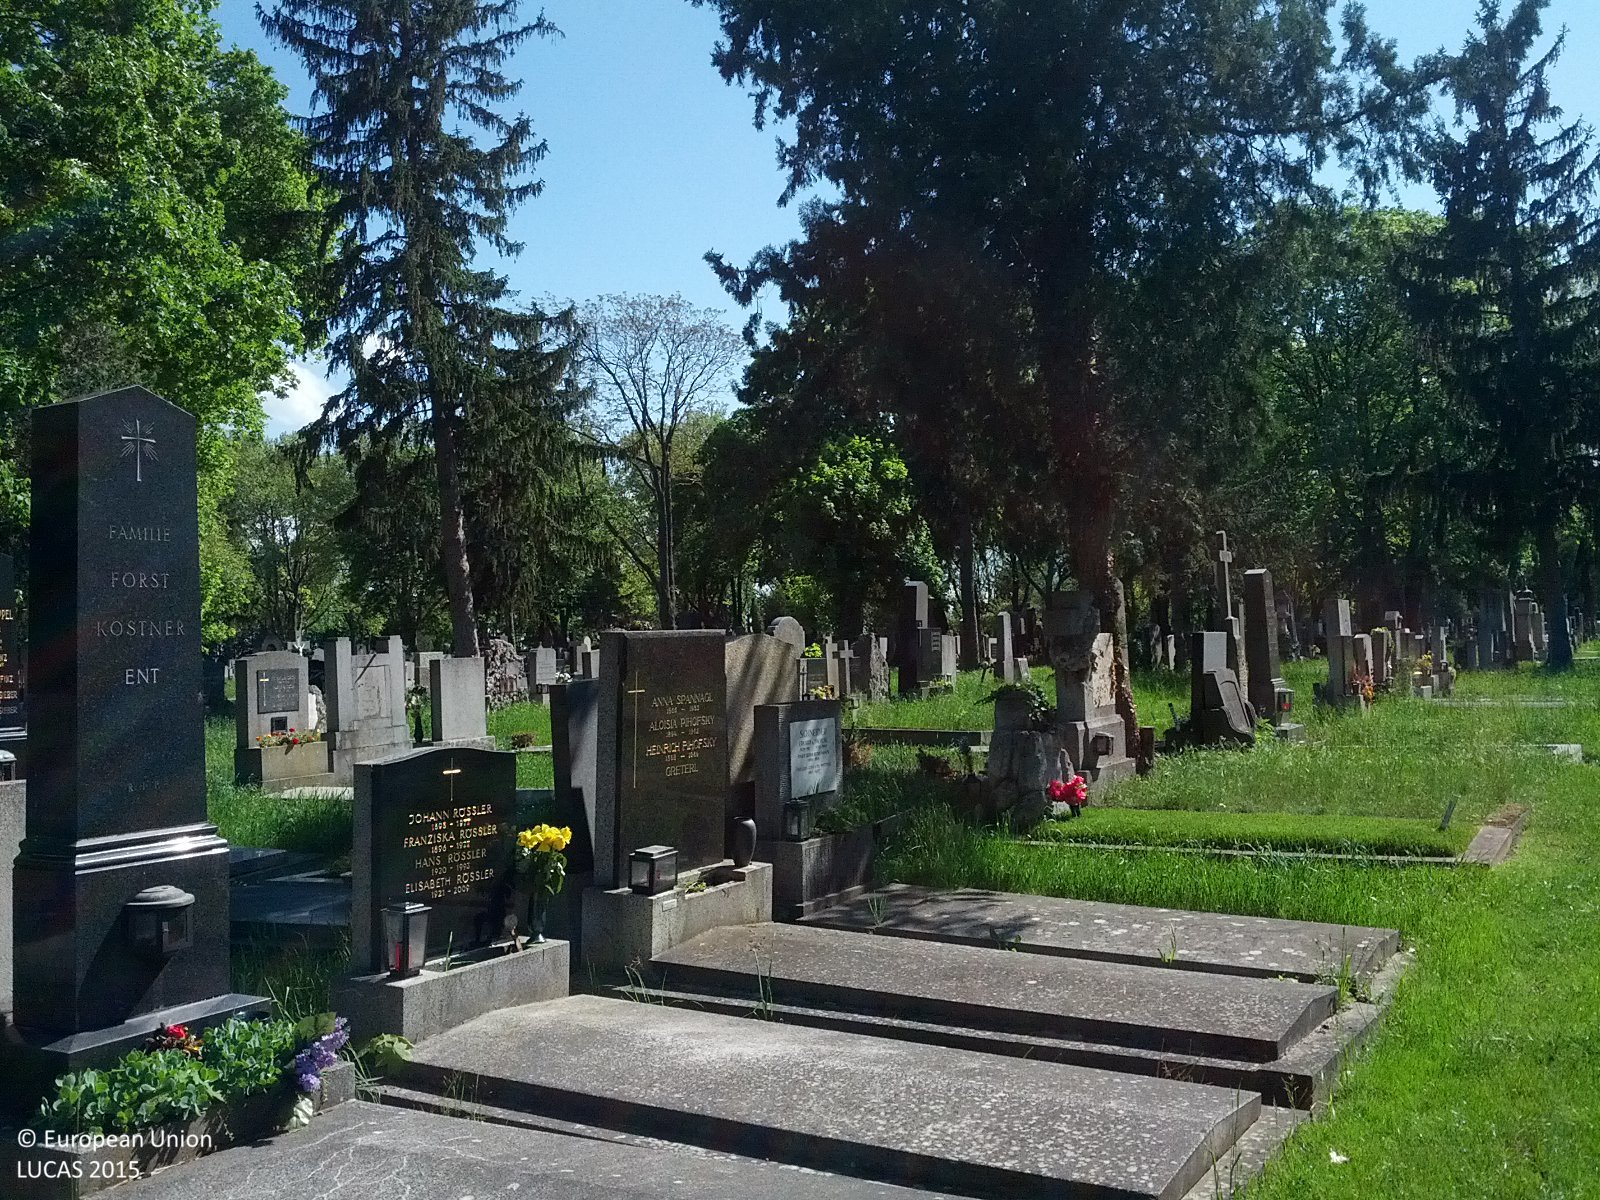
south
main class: Woodland
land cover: Broadleaved woodland
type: mesophytic deciduous forest
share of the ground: < 10 %
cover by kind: herbaceous plants 70 %, broadleaved forest trees 15 %, consolidated bare surface 15 %
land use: Community services
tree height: > 5 m
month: May
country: AT
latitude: 48.1434
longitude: 16.4428
